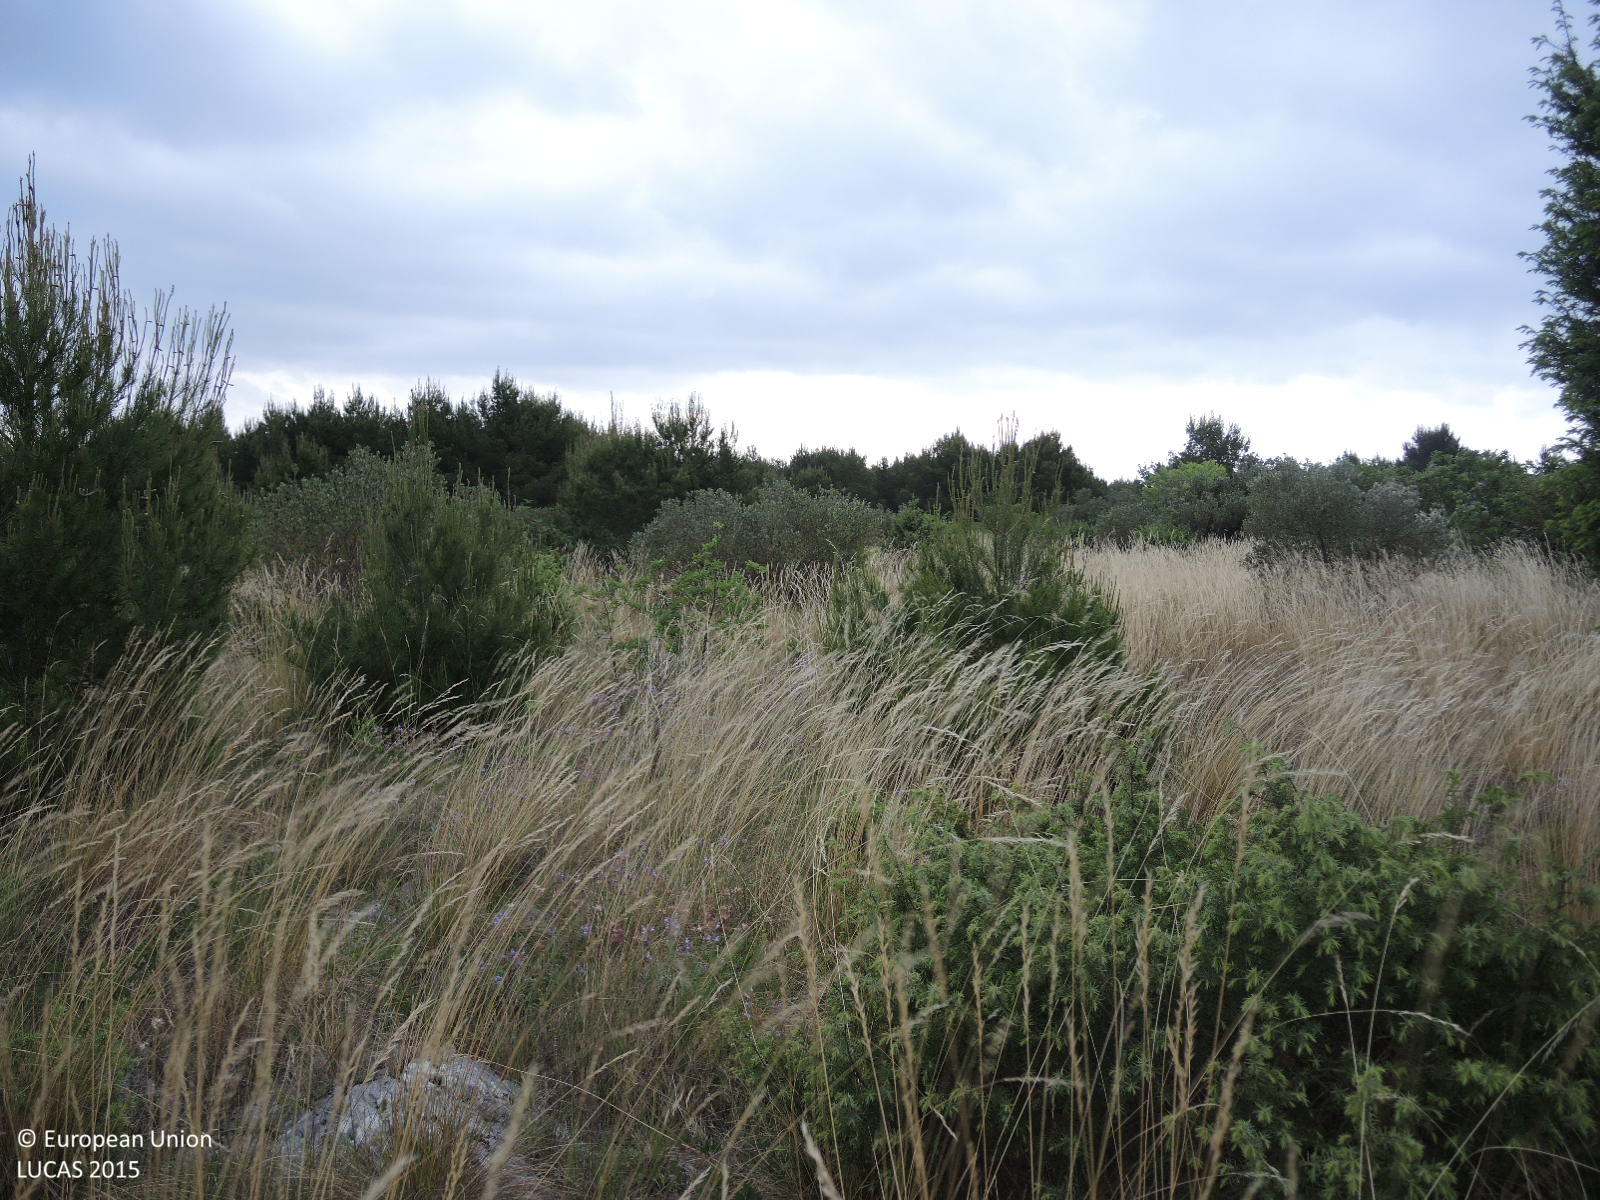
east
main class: Cropland
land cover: Olive groves
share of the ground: 10 - 25 %
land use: Agriculture (excluding fallow land and kitchen gardens)
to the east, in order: Olive groves; Dry stone walls; Shrubland with sparse tree cover; Dry stone walls; Olive groves; Dry stone walls; Olive groves; Dry stone walls; Olive groves; Dry stone walls; Olive groves
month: May
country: HR
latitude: 43.7535
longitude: 15.8158
